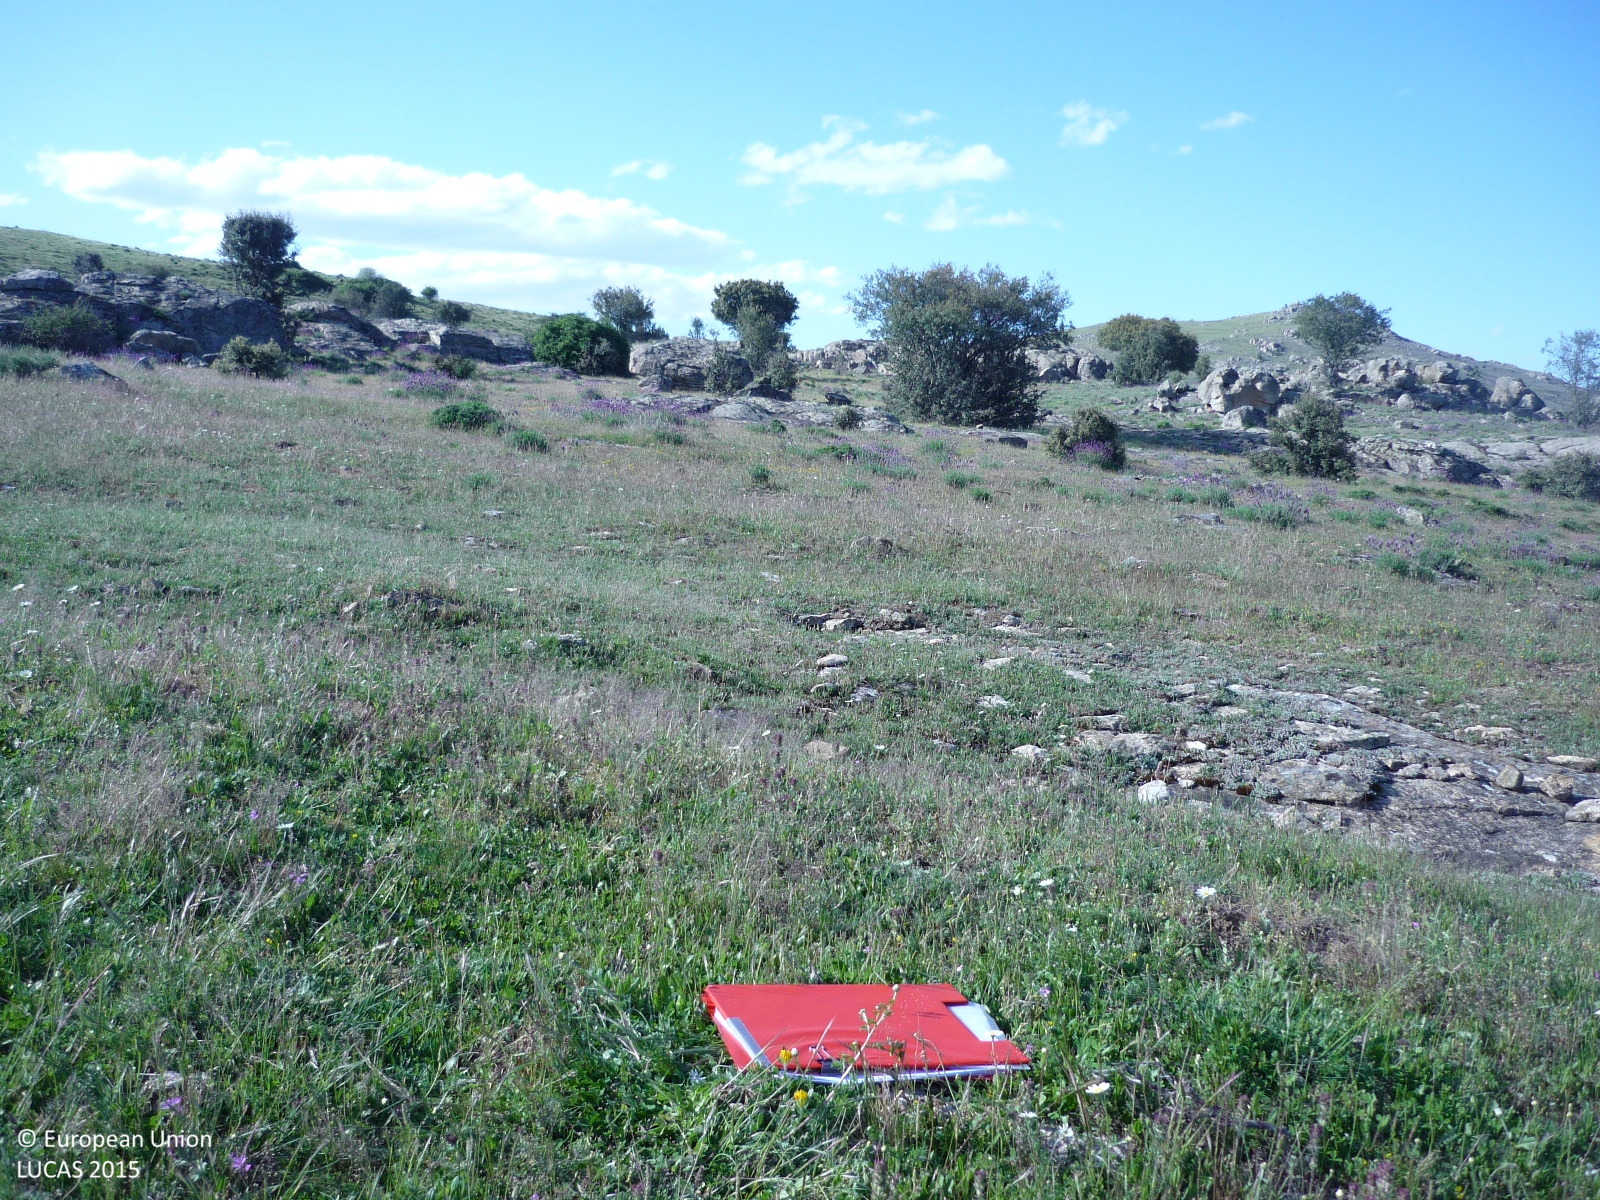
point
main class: Grassland
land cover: Grassland with sparse tree/shrub cover
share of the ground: > 75 %
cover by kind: herbaceous plants 80 %, unconsolidated bare surface 10 %, broadleaved forest trees 5 %, shrubs 5 %
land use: Agriculture (excluding fallow land and kitchen gardens)
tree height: < 5 m
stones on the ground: < 10 %
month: May
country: ES
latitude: 41.0167
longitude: -3.6121
